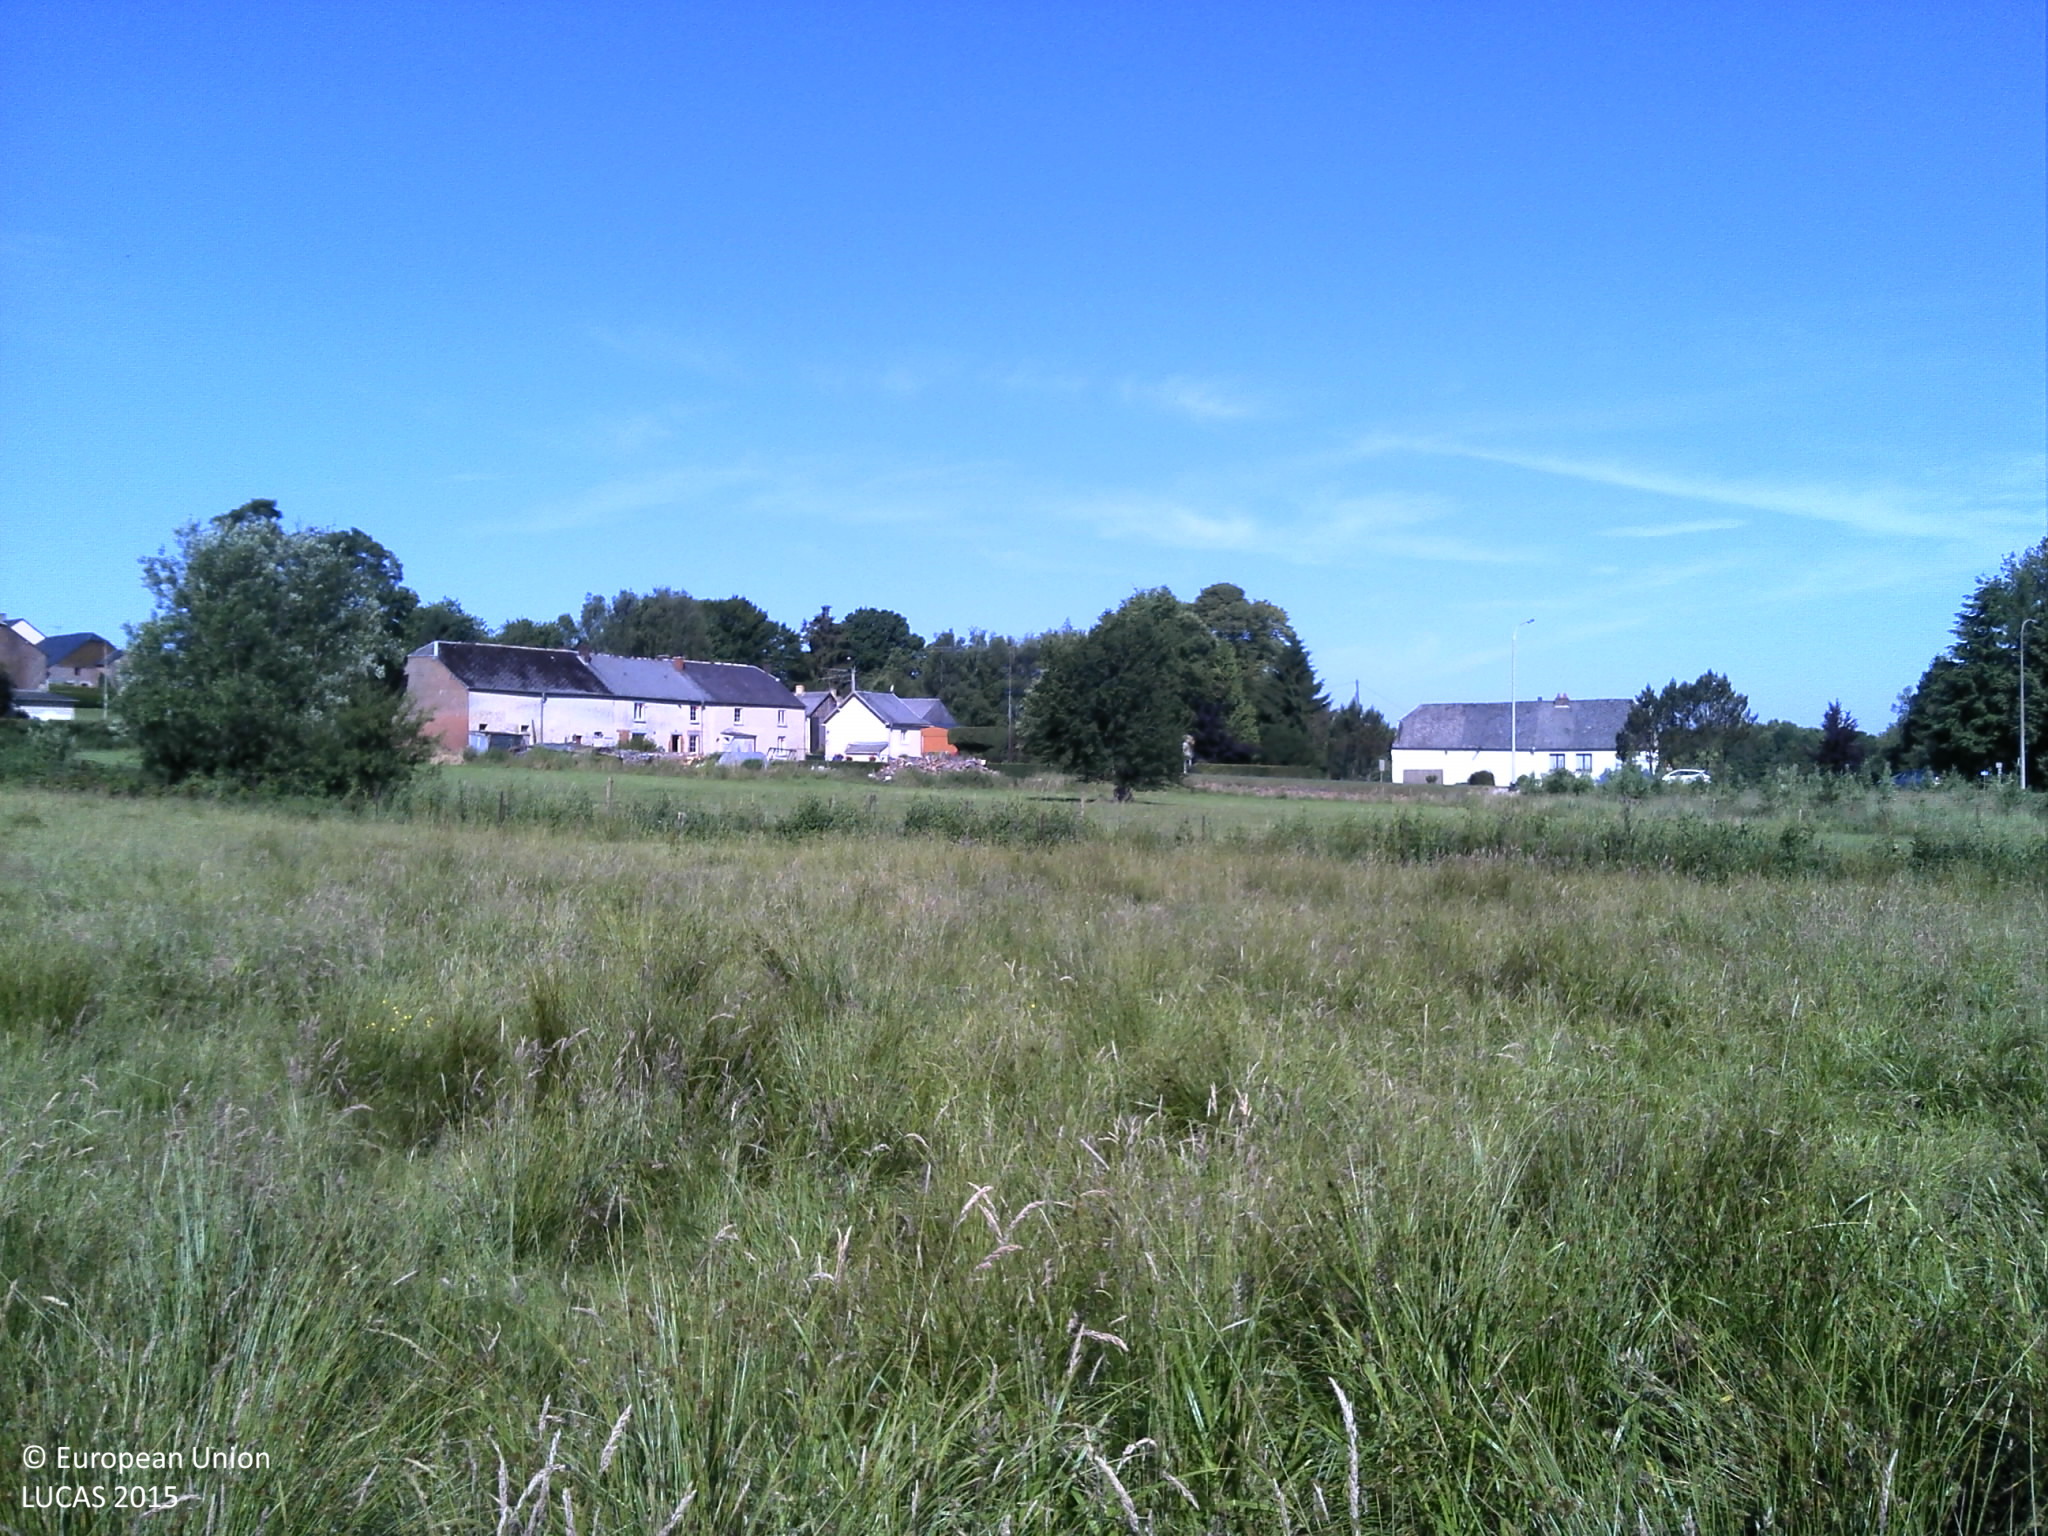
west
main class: Grassland
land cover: Grassland without tree/shrub cover
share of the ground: > 75 %
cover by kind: herbaceous plants 100 %
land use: Agriculture (excluding fallow land and kitchen gardens)
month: July
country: FR
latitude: 49.9403
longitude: 4.4362
